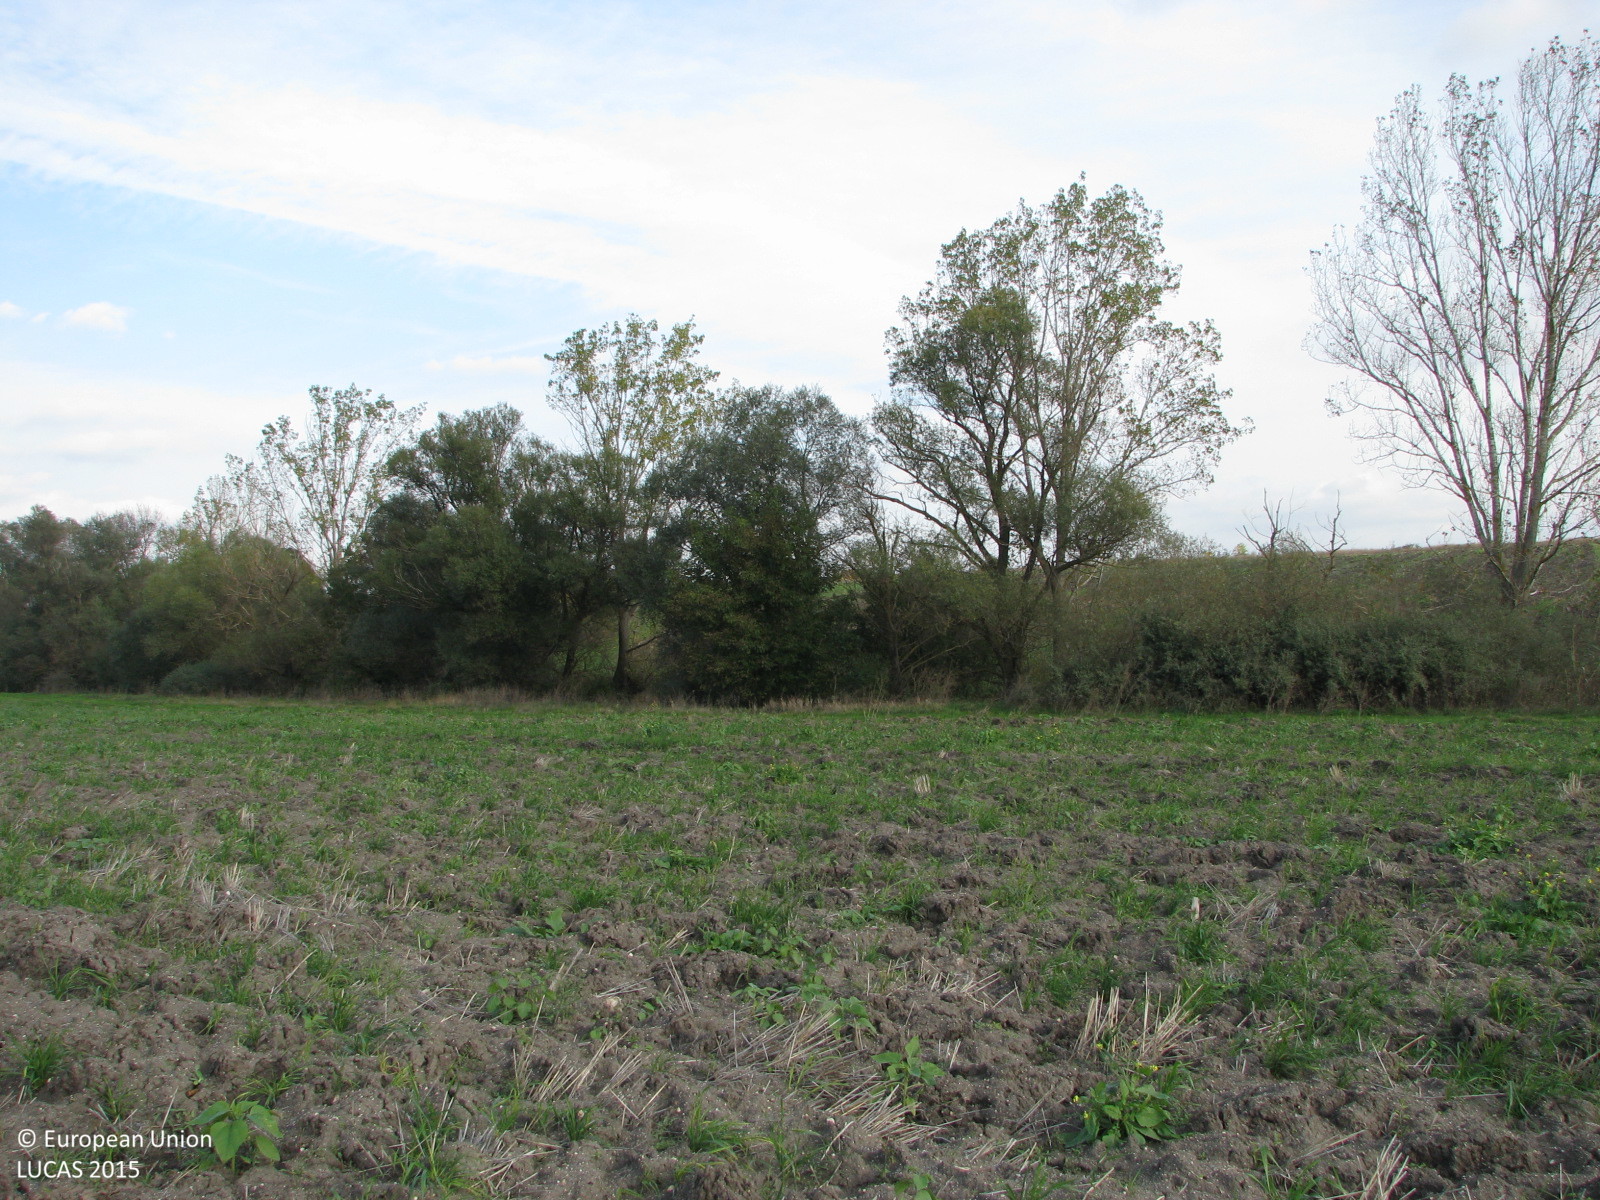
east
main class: Grassland
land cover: Spontaneously vegetated surfaces
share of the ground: 25 - 50 %
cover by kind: unconsolidated bare surface 65 %, herbaceous plants 35 %
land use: Agriculture (excluding fallow land and kitchen gardens)
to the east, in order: Spontaneously vegetated surfaces; Tracks; Grass margins; Broadleaved woodland; Ditches and canals; Broadleaved woodland; Grass margins; Tracks; Spontaneously vegetated surfaces
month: October
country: BG
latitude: 42.2520
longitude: 26.6868
